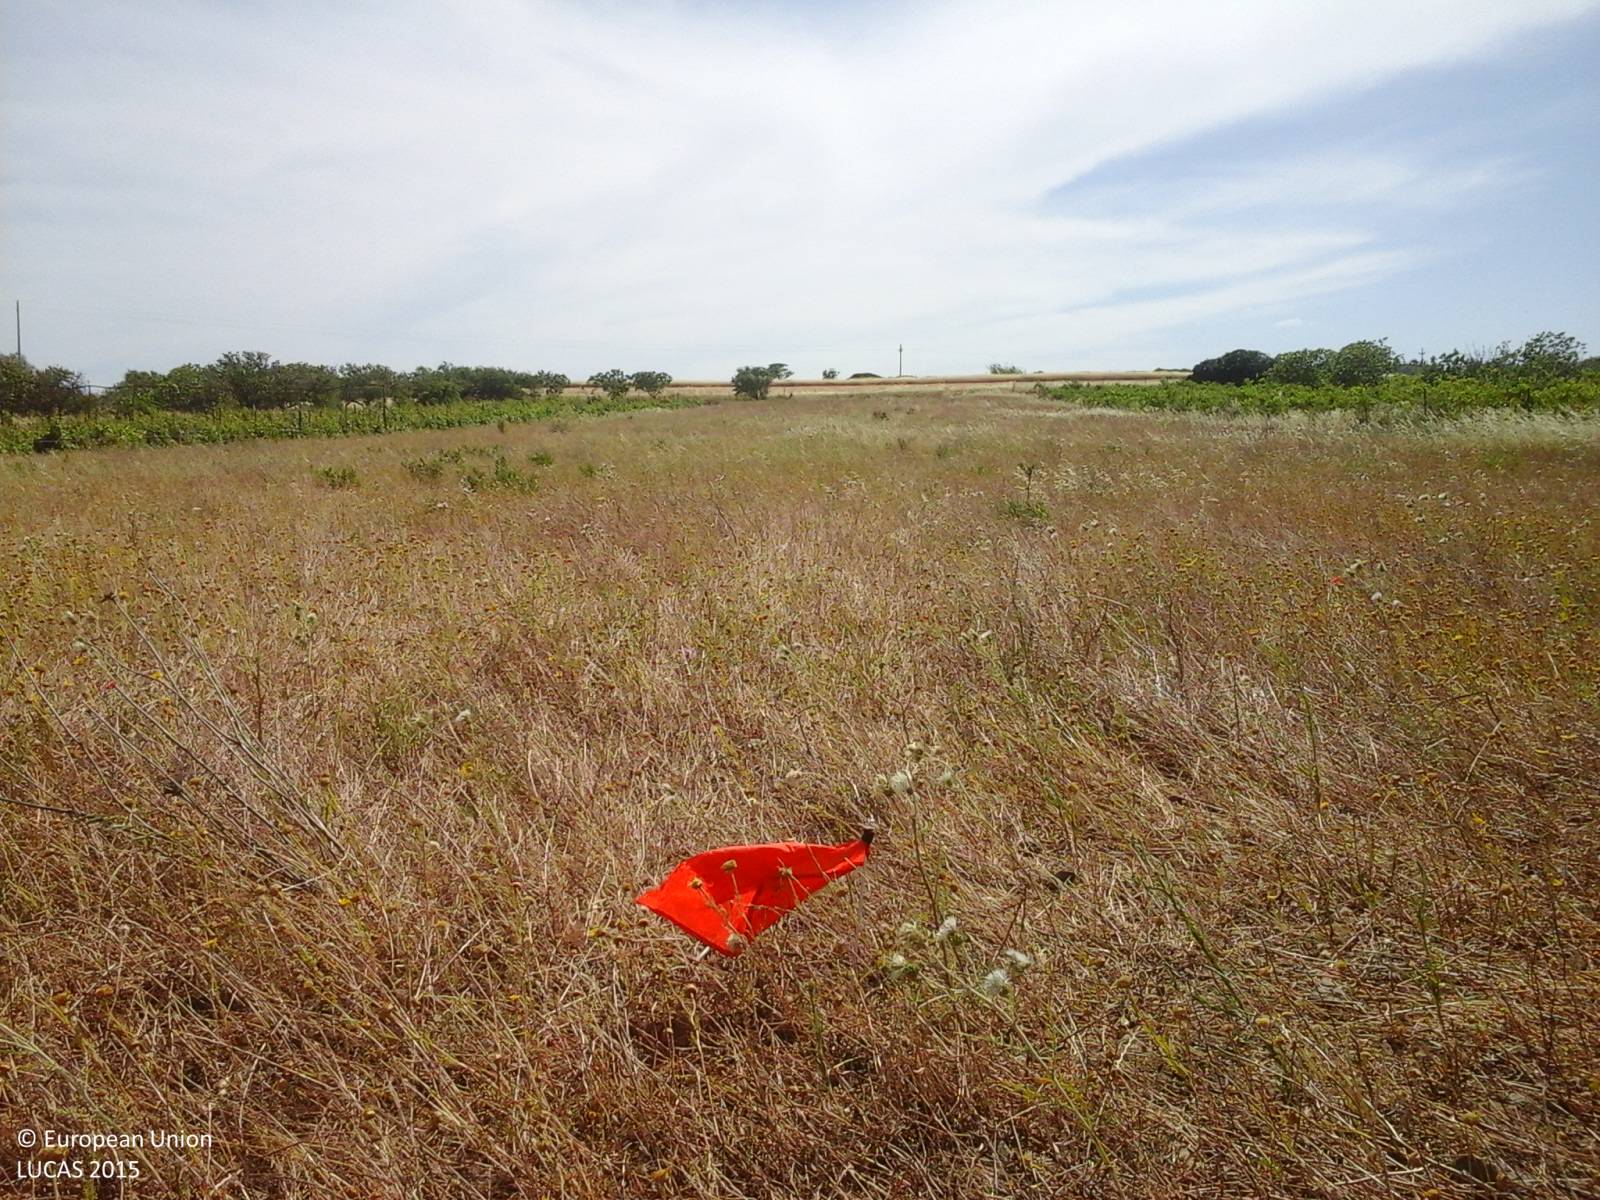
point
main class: Grassland
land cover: Spontaneously vegetated surfaces
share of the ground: > 75 %
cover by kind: herbaceous plants 100 %
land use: Fallow land
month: May
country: IT
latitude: 39.2681
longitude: 9.2282
